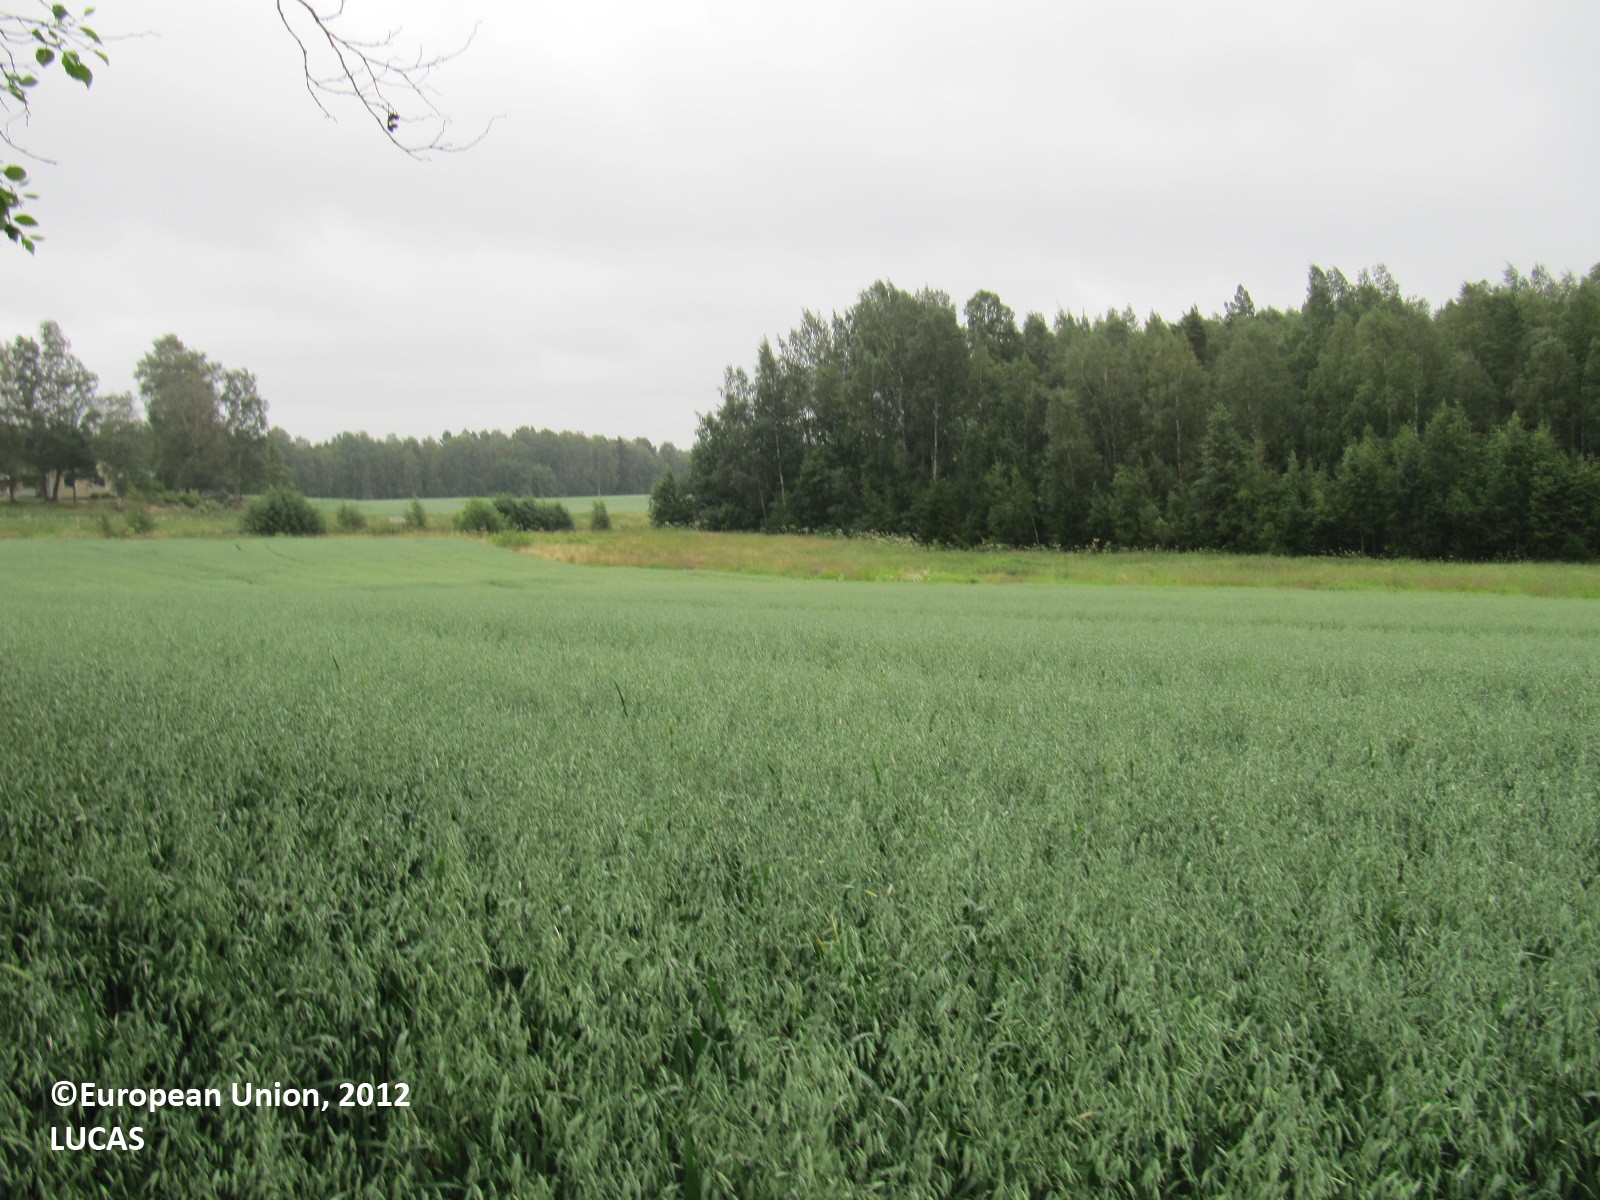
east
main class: Cropland
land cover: Oats
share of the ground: > 75 %
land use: Agriculture (excluding fallow land and kitchen gardens)
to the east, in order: Oats; Spontaneously vegetated surfaces; Ditches and canals; Spontaneously vegetated surfaces; Oats; Arable land (only in case pi)
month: July
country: FI
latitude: 60.3046
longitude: 23.7927
